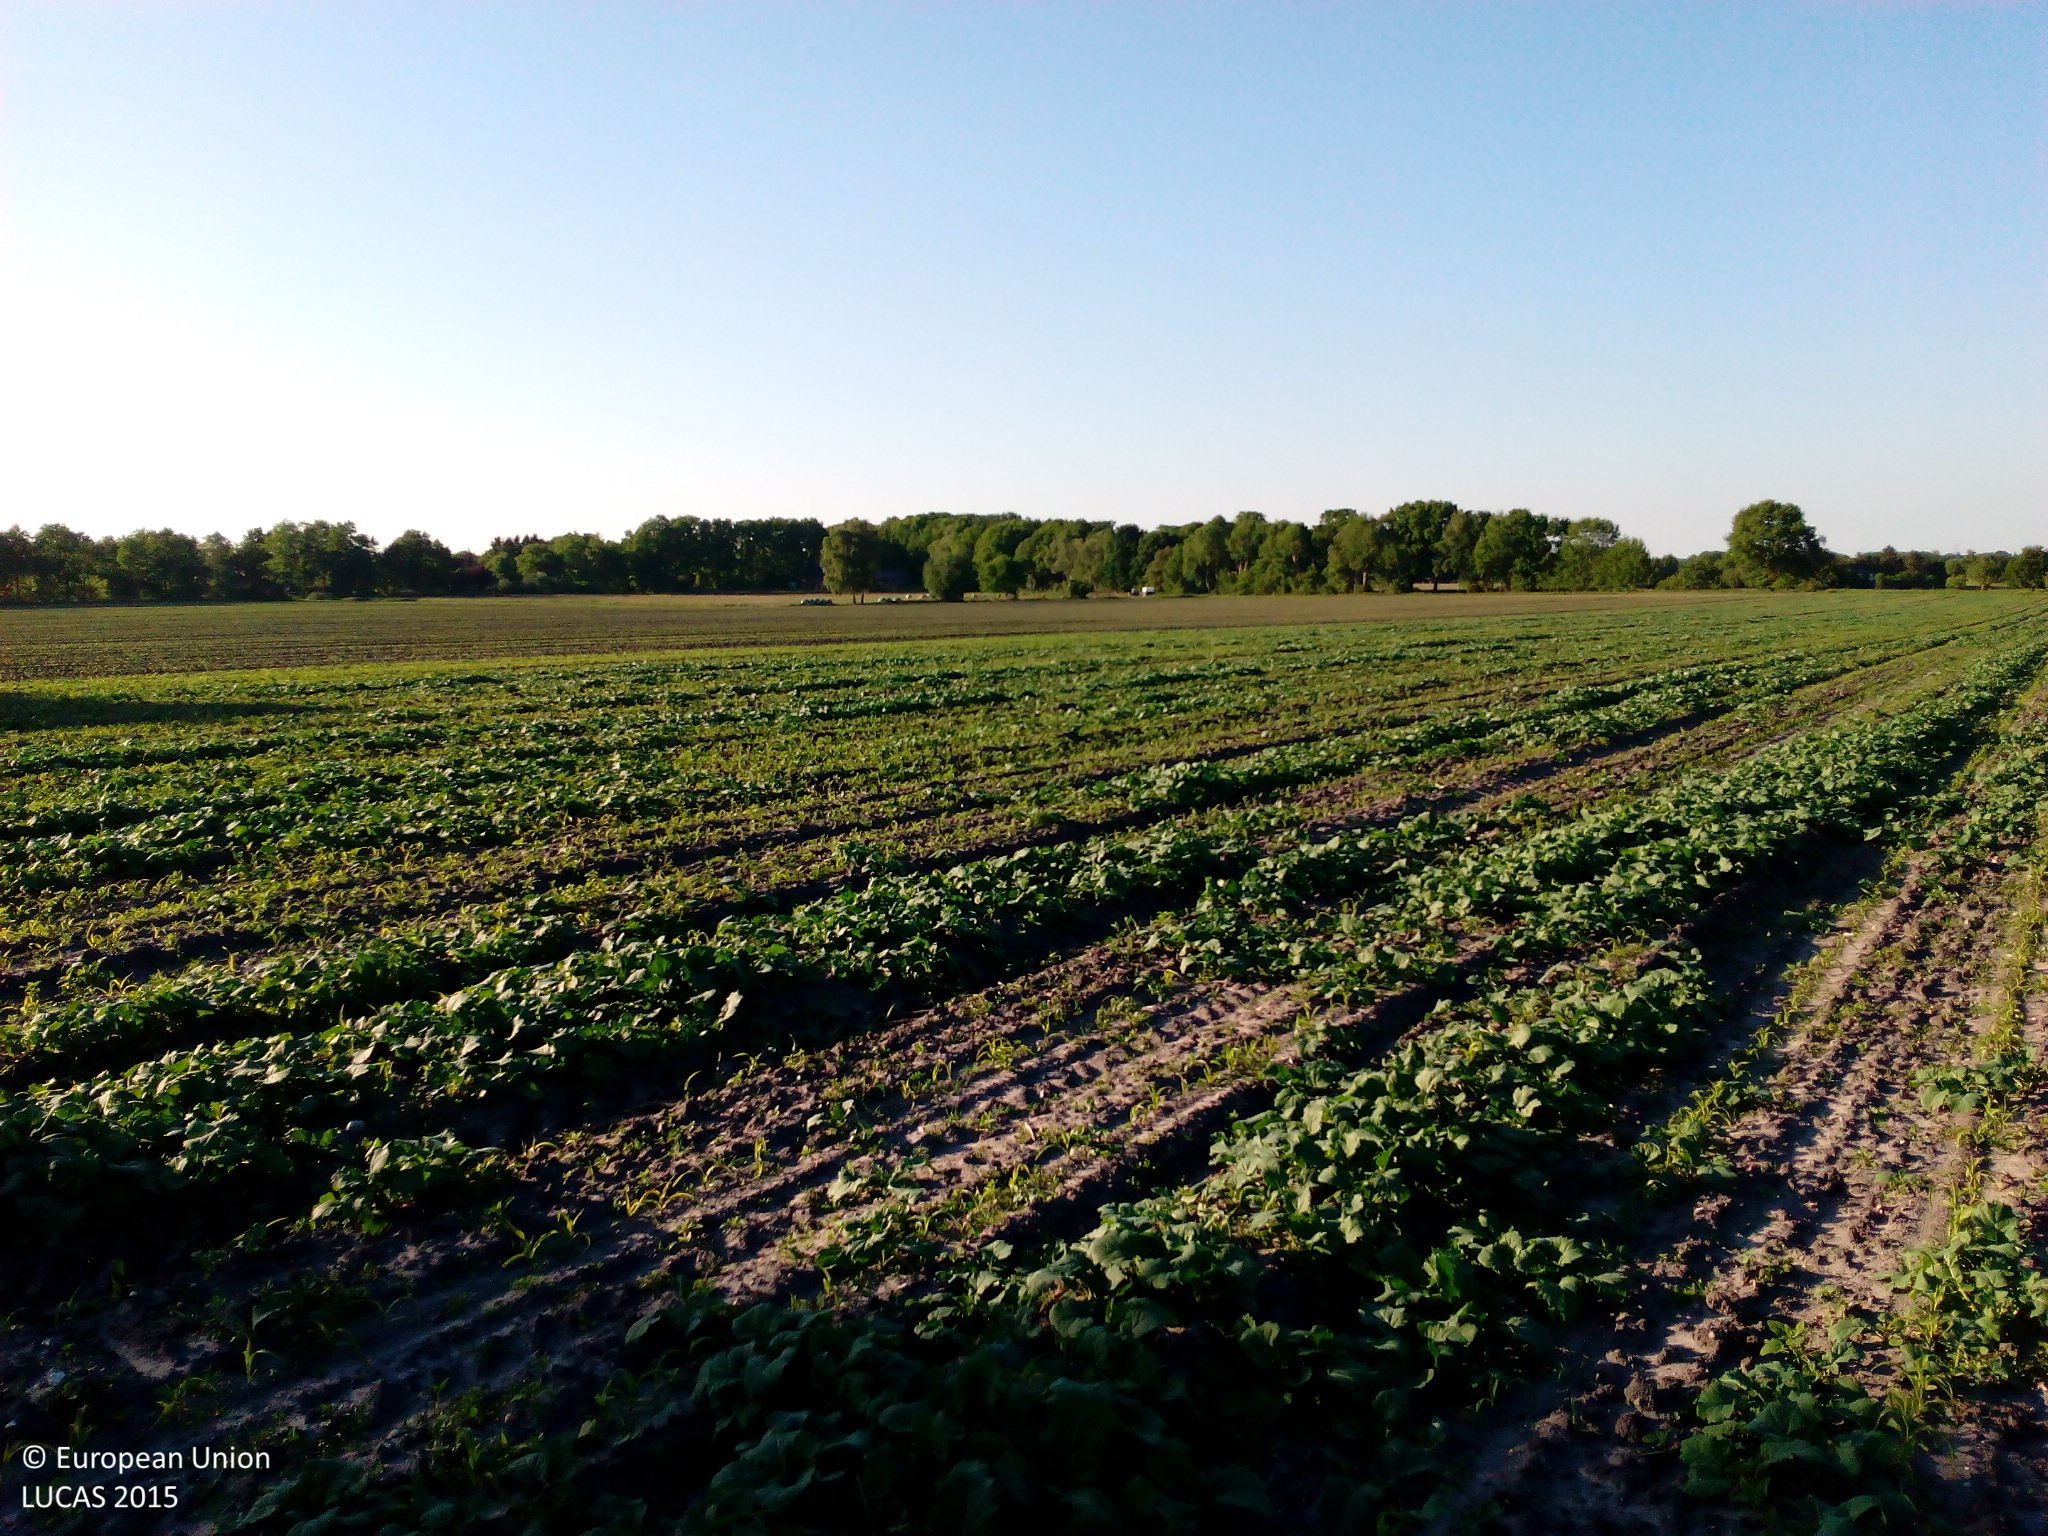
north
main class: Cropland
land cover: Sugar beet
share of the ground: 25 - 50 %
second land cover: Maize
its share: < 10 %
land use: Agriculture (excluding fallow land and kitchen gardens)
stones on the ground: < 10 %
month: June
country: DE
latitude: 53.5071
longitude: 9.2013
